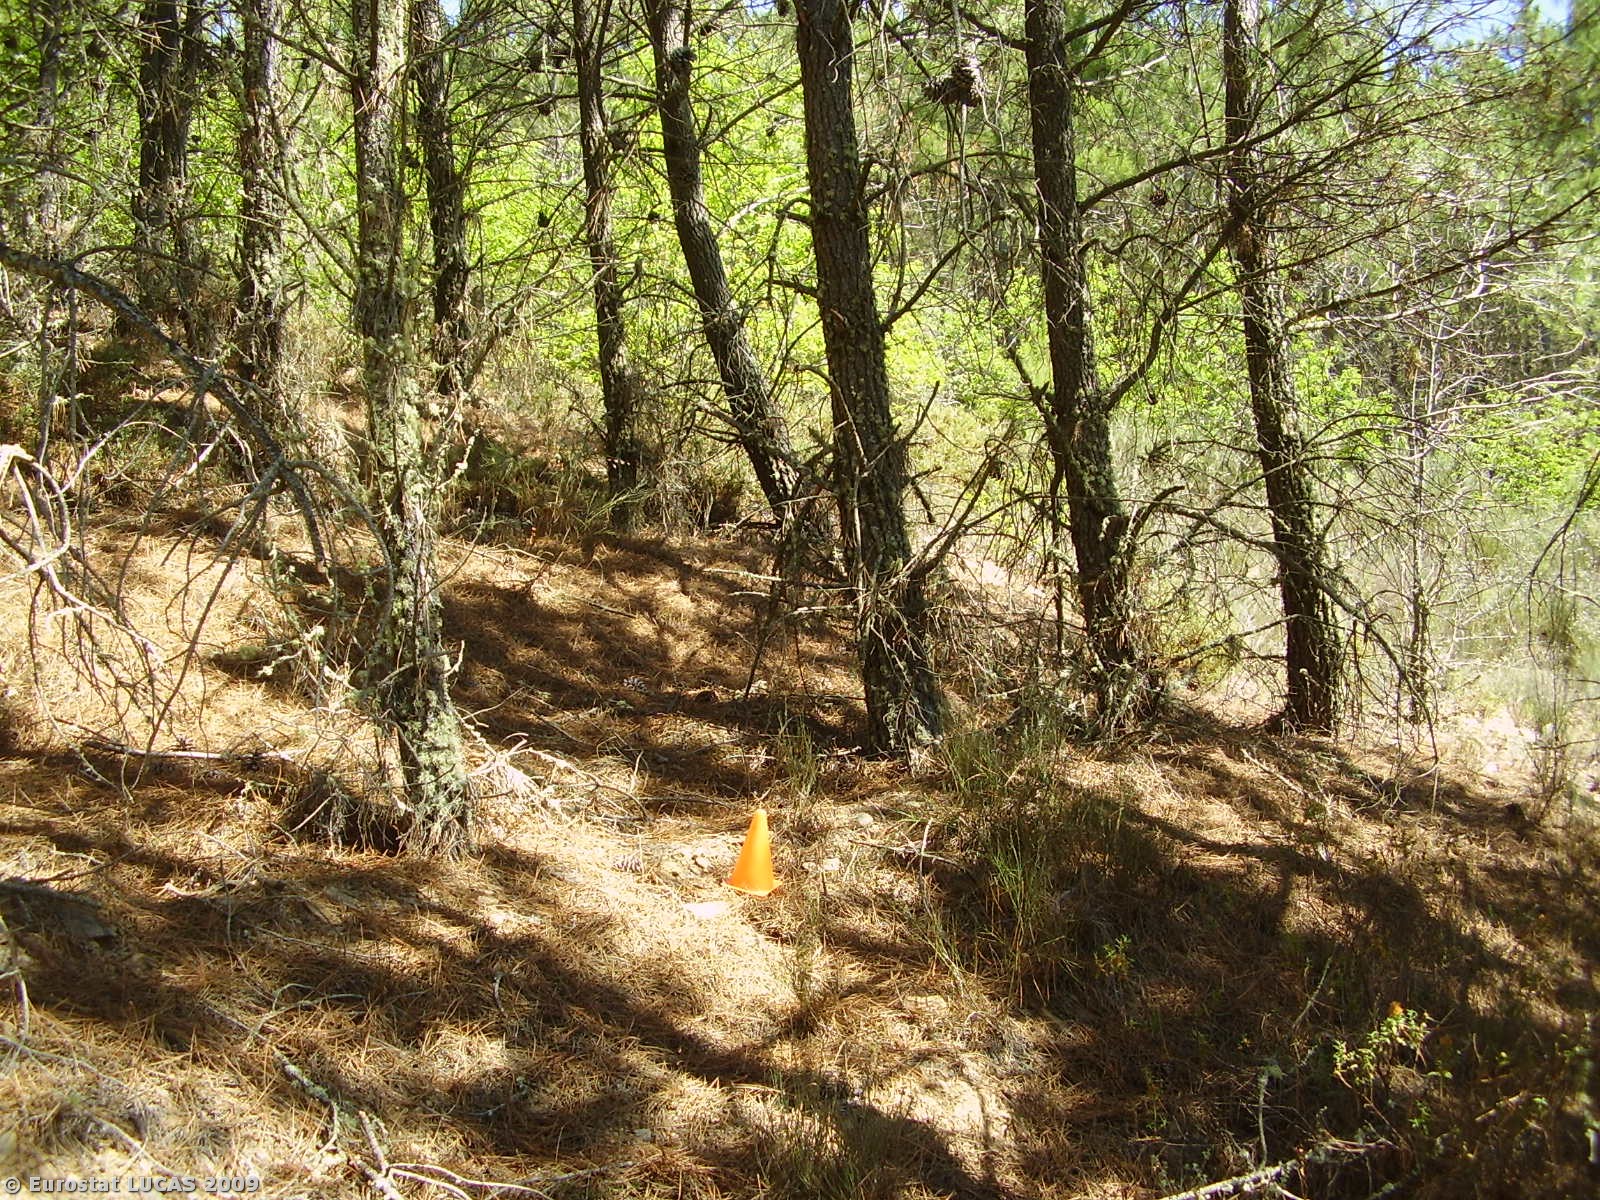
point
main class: Woodland
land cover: Coniferous woodland
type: coniferous forest of the mediterranean region
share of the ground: 10 - 25 %
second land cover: Bare land
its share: > 75 %
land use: Forestry
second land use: Fallow land
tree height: > 5 m
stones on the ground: > 50 %
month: August
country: PT
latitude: 41.2081
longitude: -6.7652
